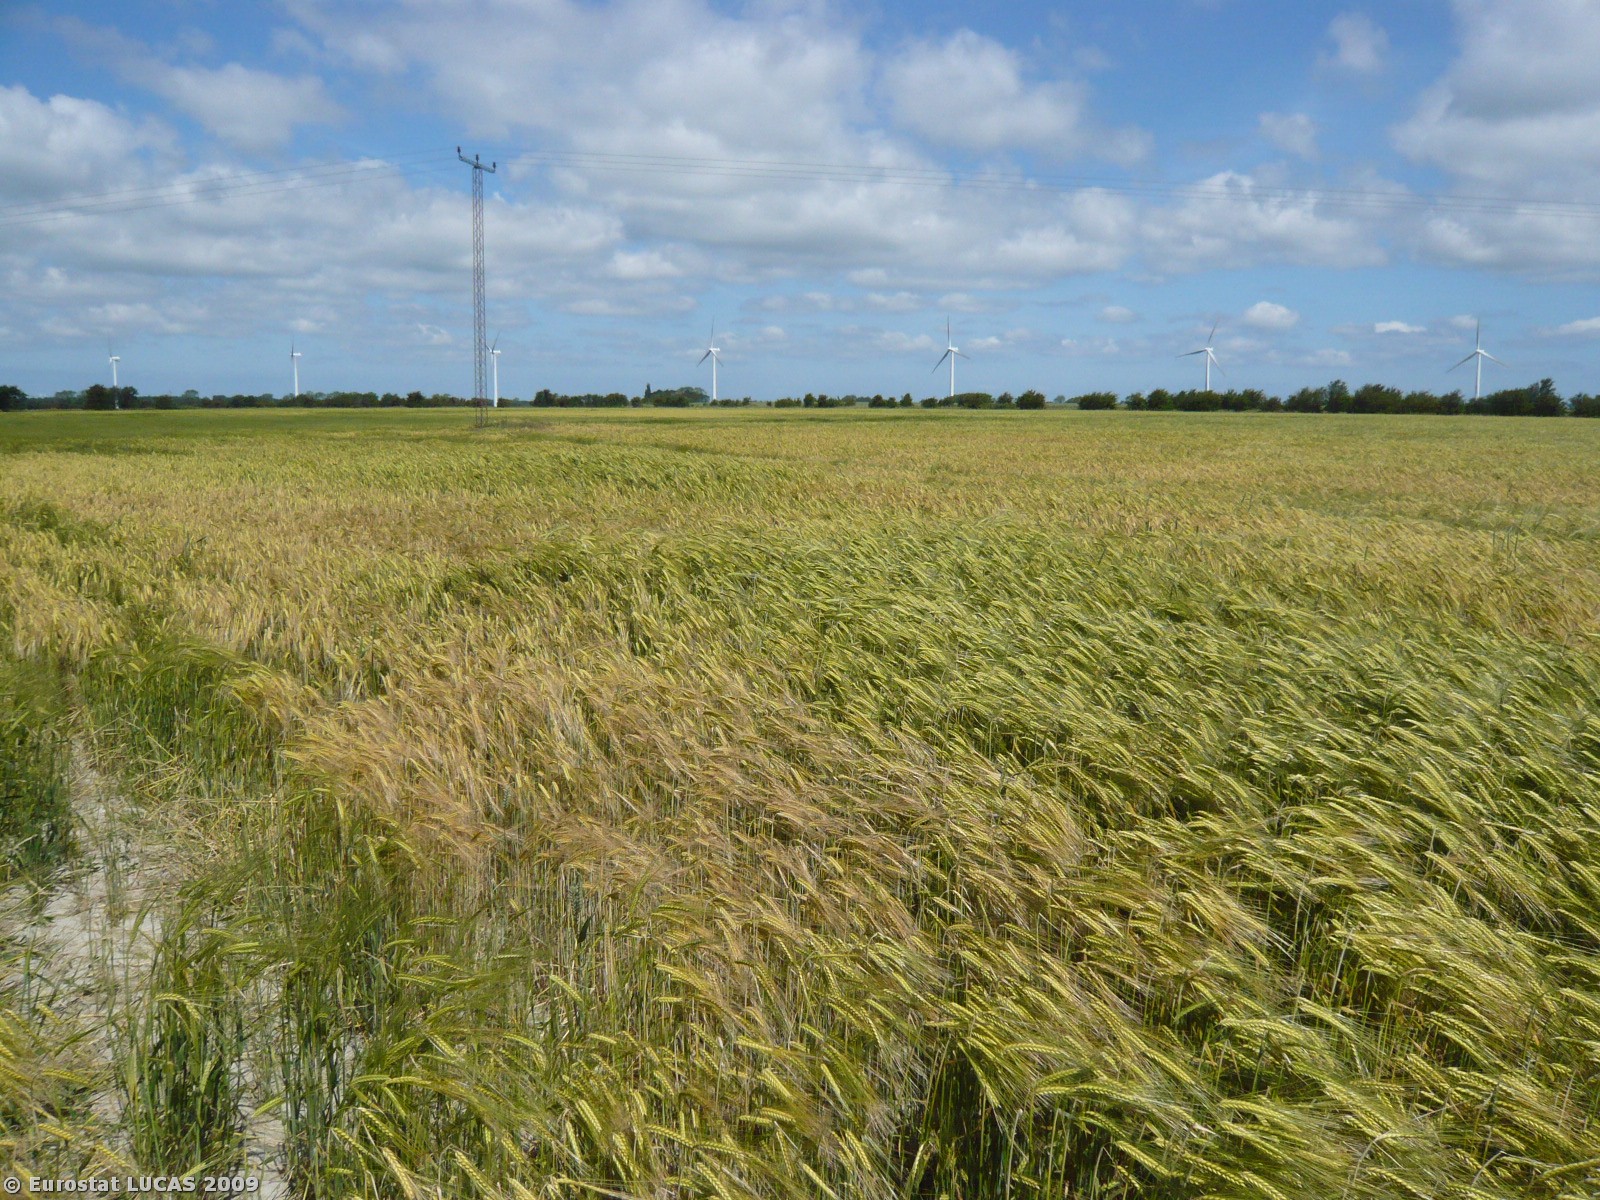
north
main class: Cropland
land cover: Barley
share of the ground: 50 - 75 %
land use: Agriculture (excluding fallow land and kitchen gardens)
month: June
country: DK
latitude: 54.7069
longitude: 11.3183
